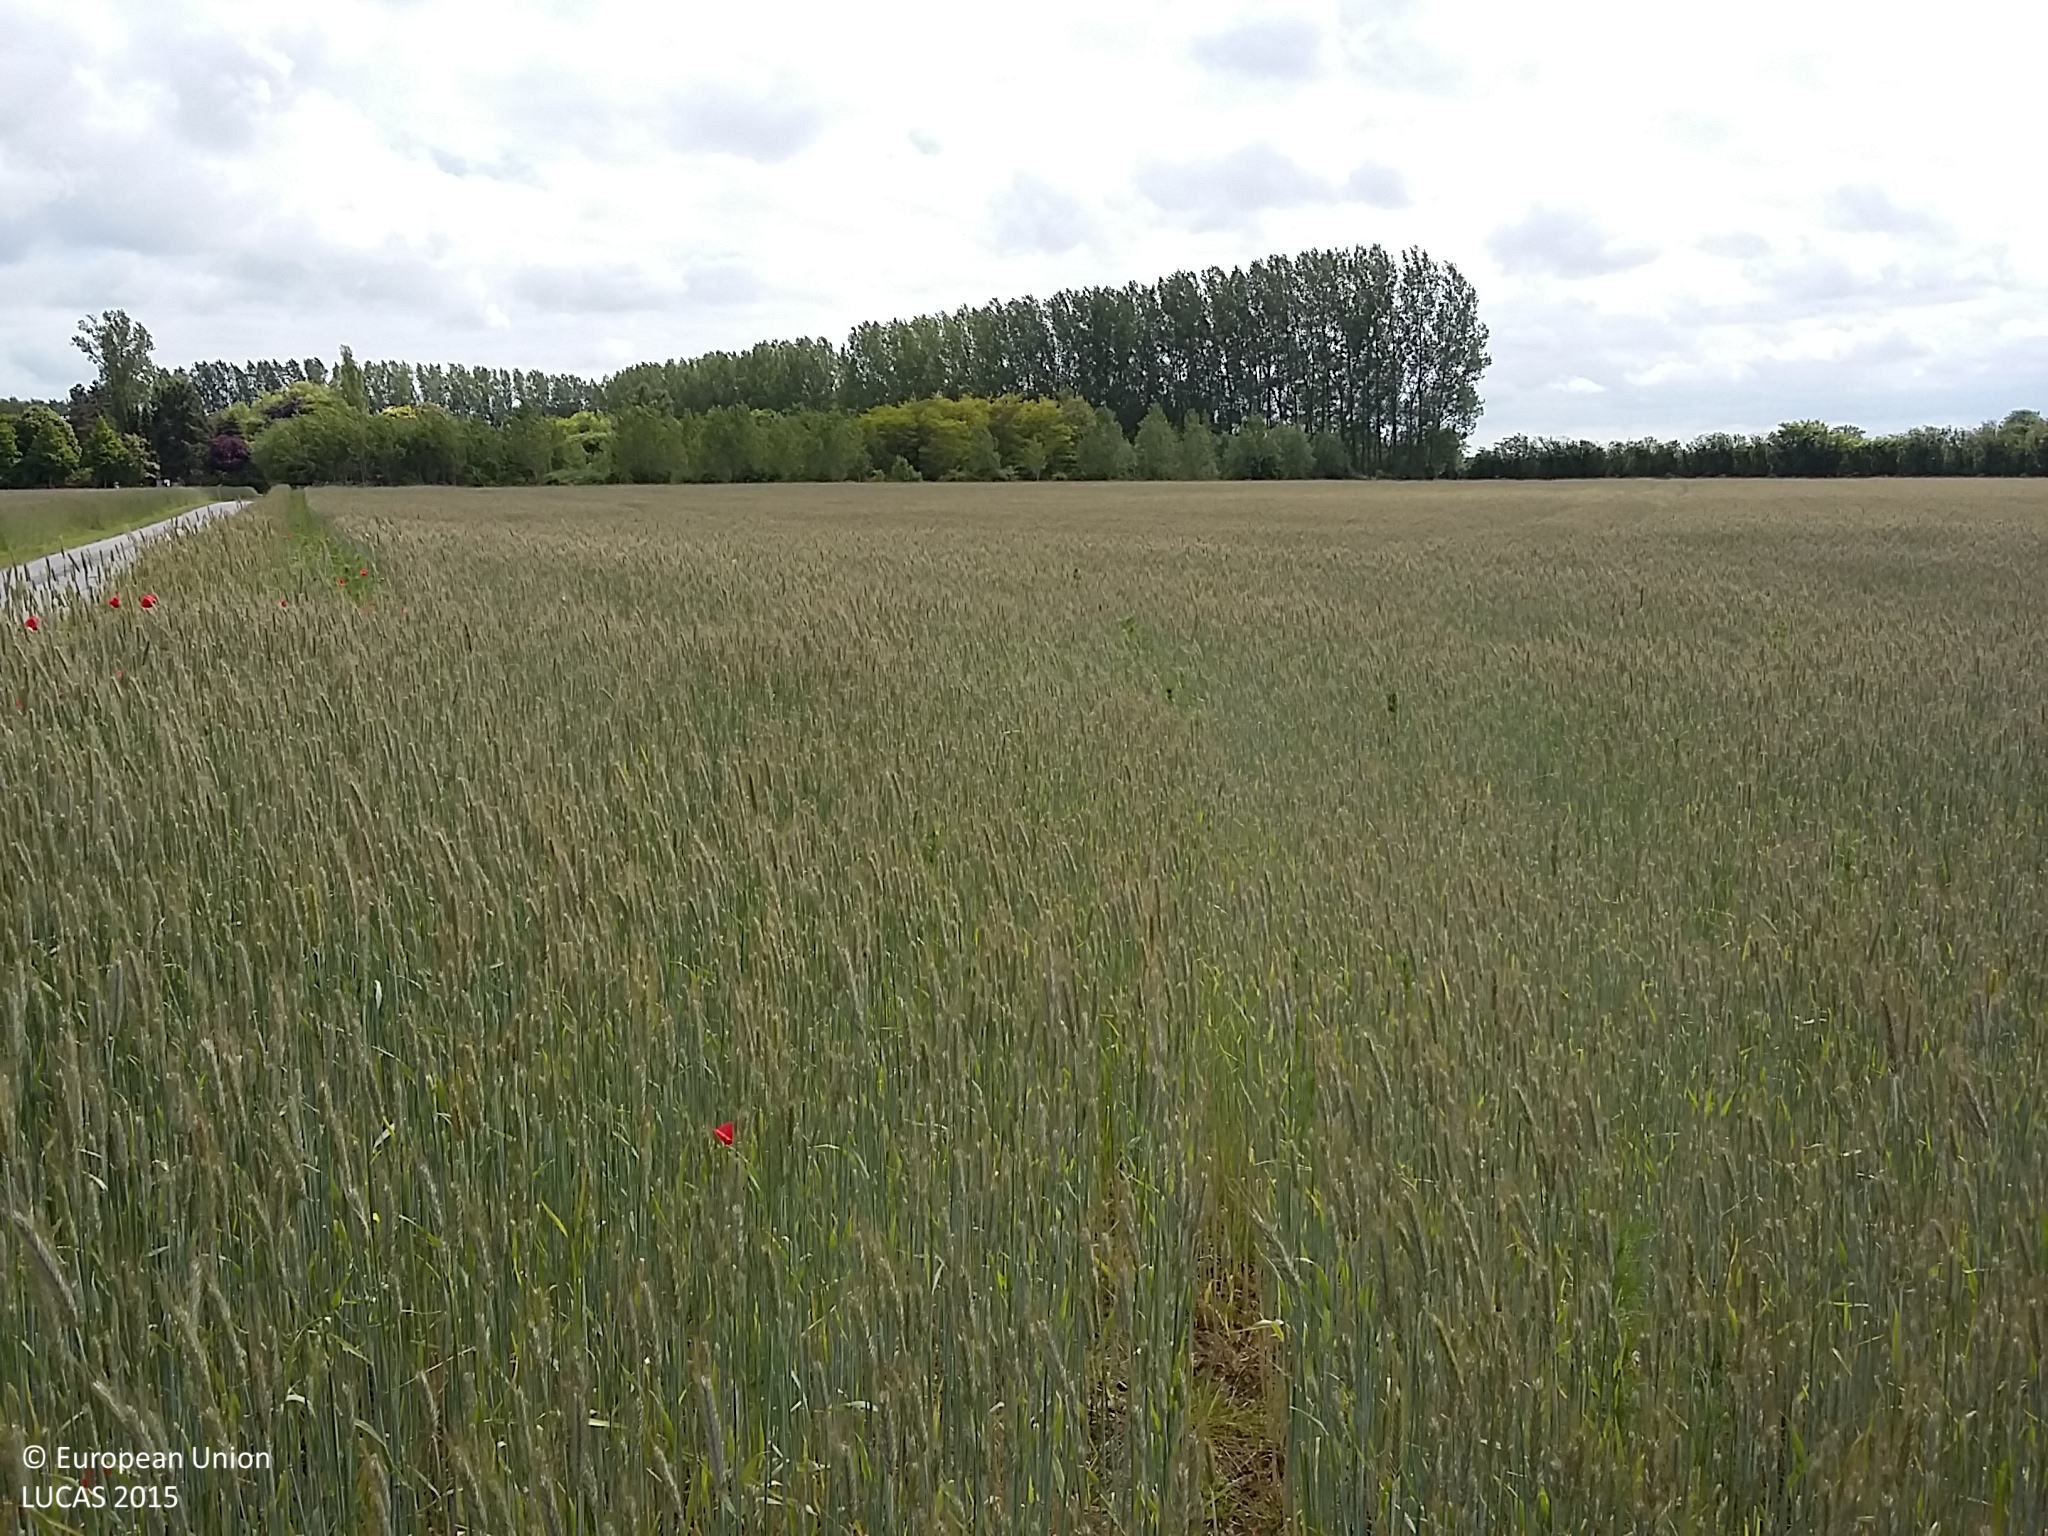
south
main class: Cropland
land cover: Rye
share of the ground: > 75 %
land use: Agriculture (excluding fallow land and kitchen gardens)
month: June
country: DK
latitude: 55.3055
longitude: 10.6138
